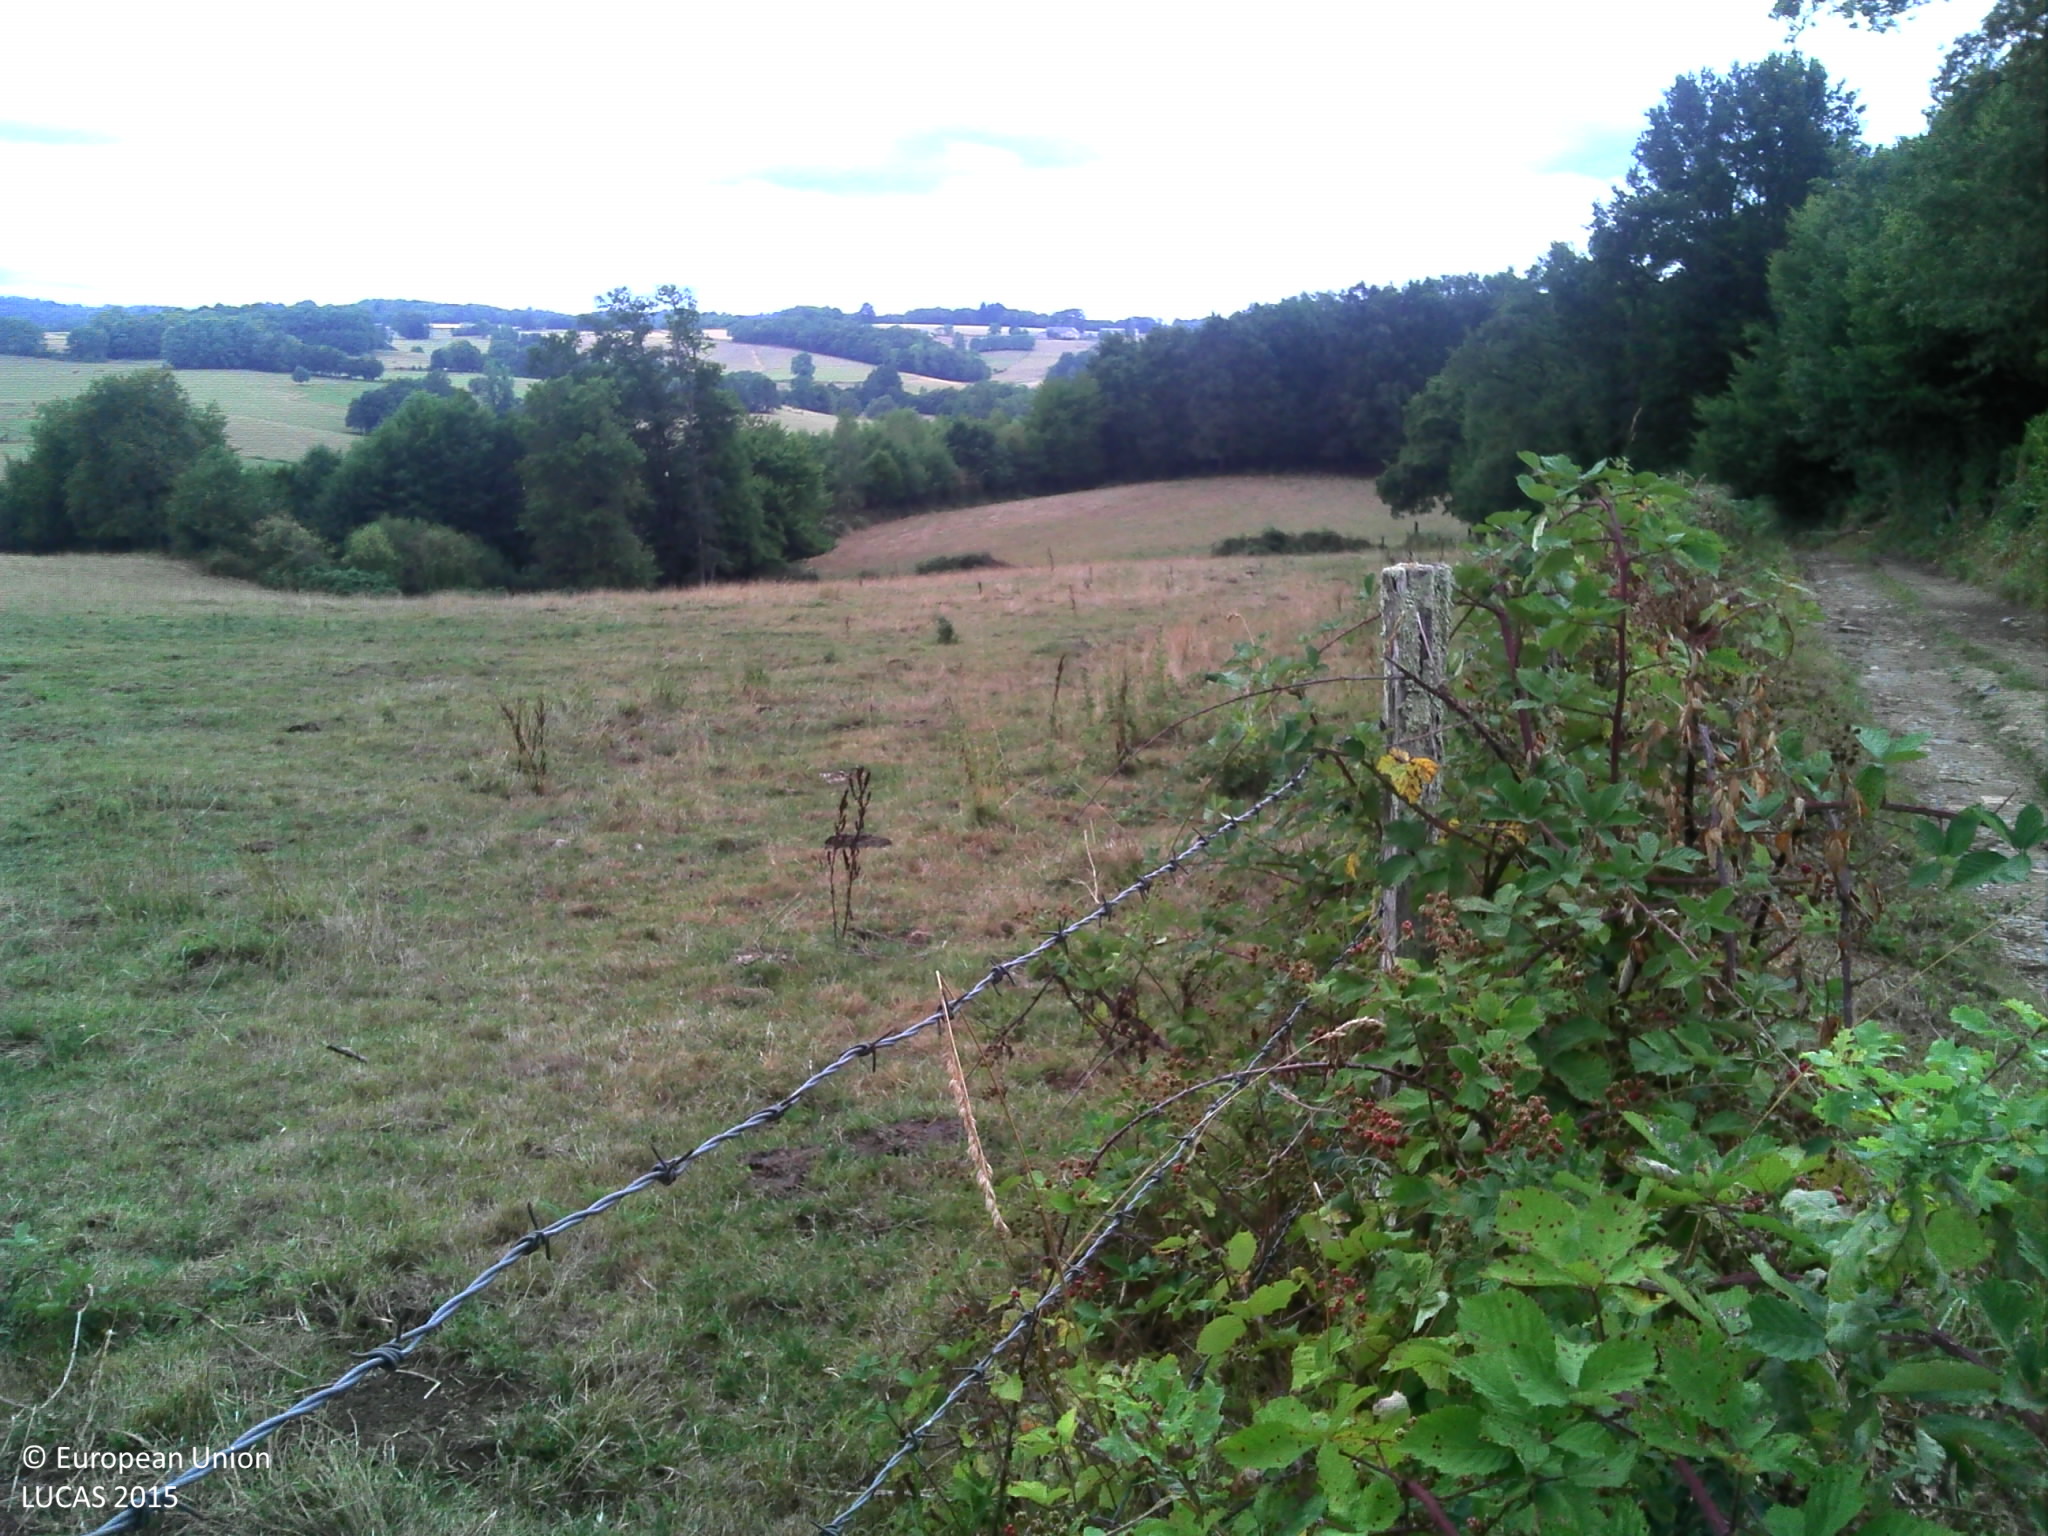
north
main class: Grassland
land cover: Grassland without tree/shrub cover
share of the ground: > 75 %
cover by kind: herbaceous plants 100 %
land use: Agriculture (excluding fallow land and kitchen gardens)
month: August
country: FR
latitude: 45.4645
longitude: 1.6687
